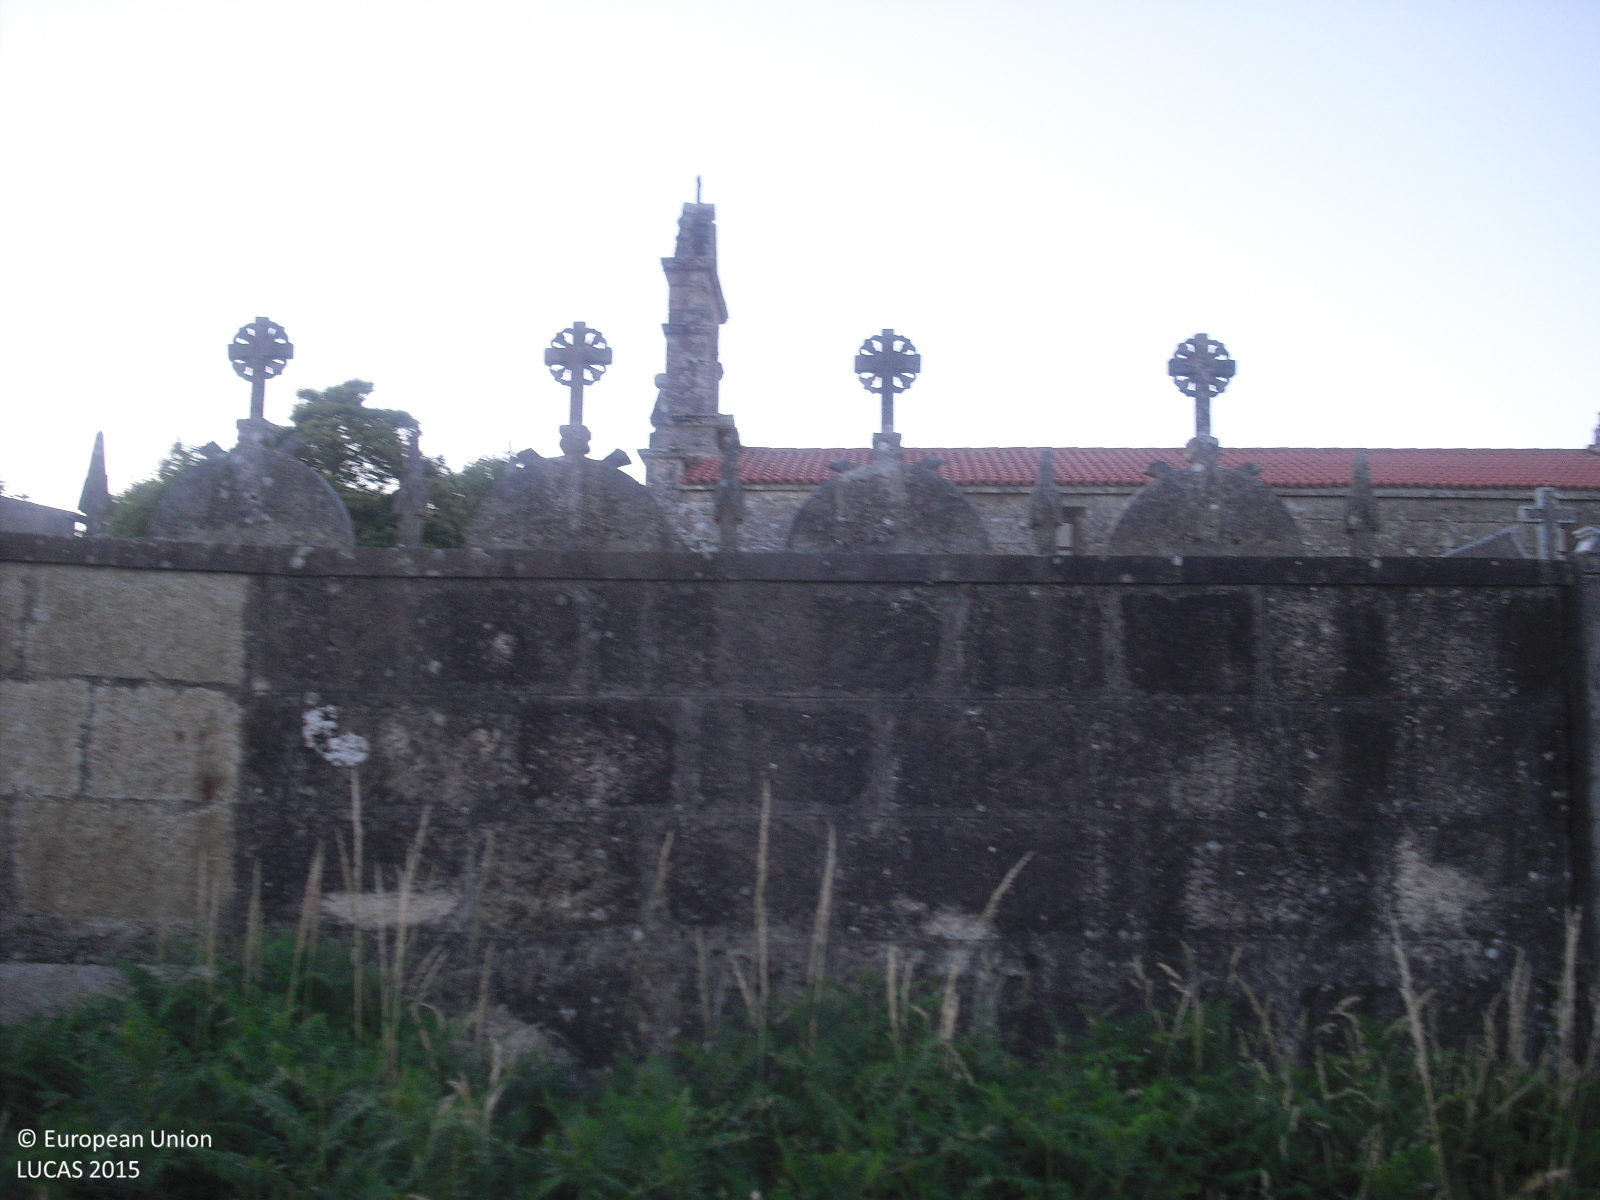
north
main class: Shrubland
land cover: Shrubland without tree cover
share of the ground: 50 - 75 %
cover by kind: shrubs 70 %, herbaceous plants 30 %
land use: Abandoned areas
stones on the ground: 25 - 50 %
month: June
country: ES
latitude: 42.4697
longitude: -7.8731
